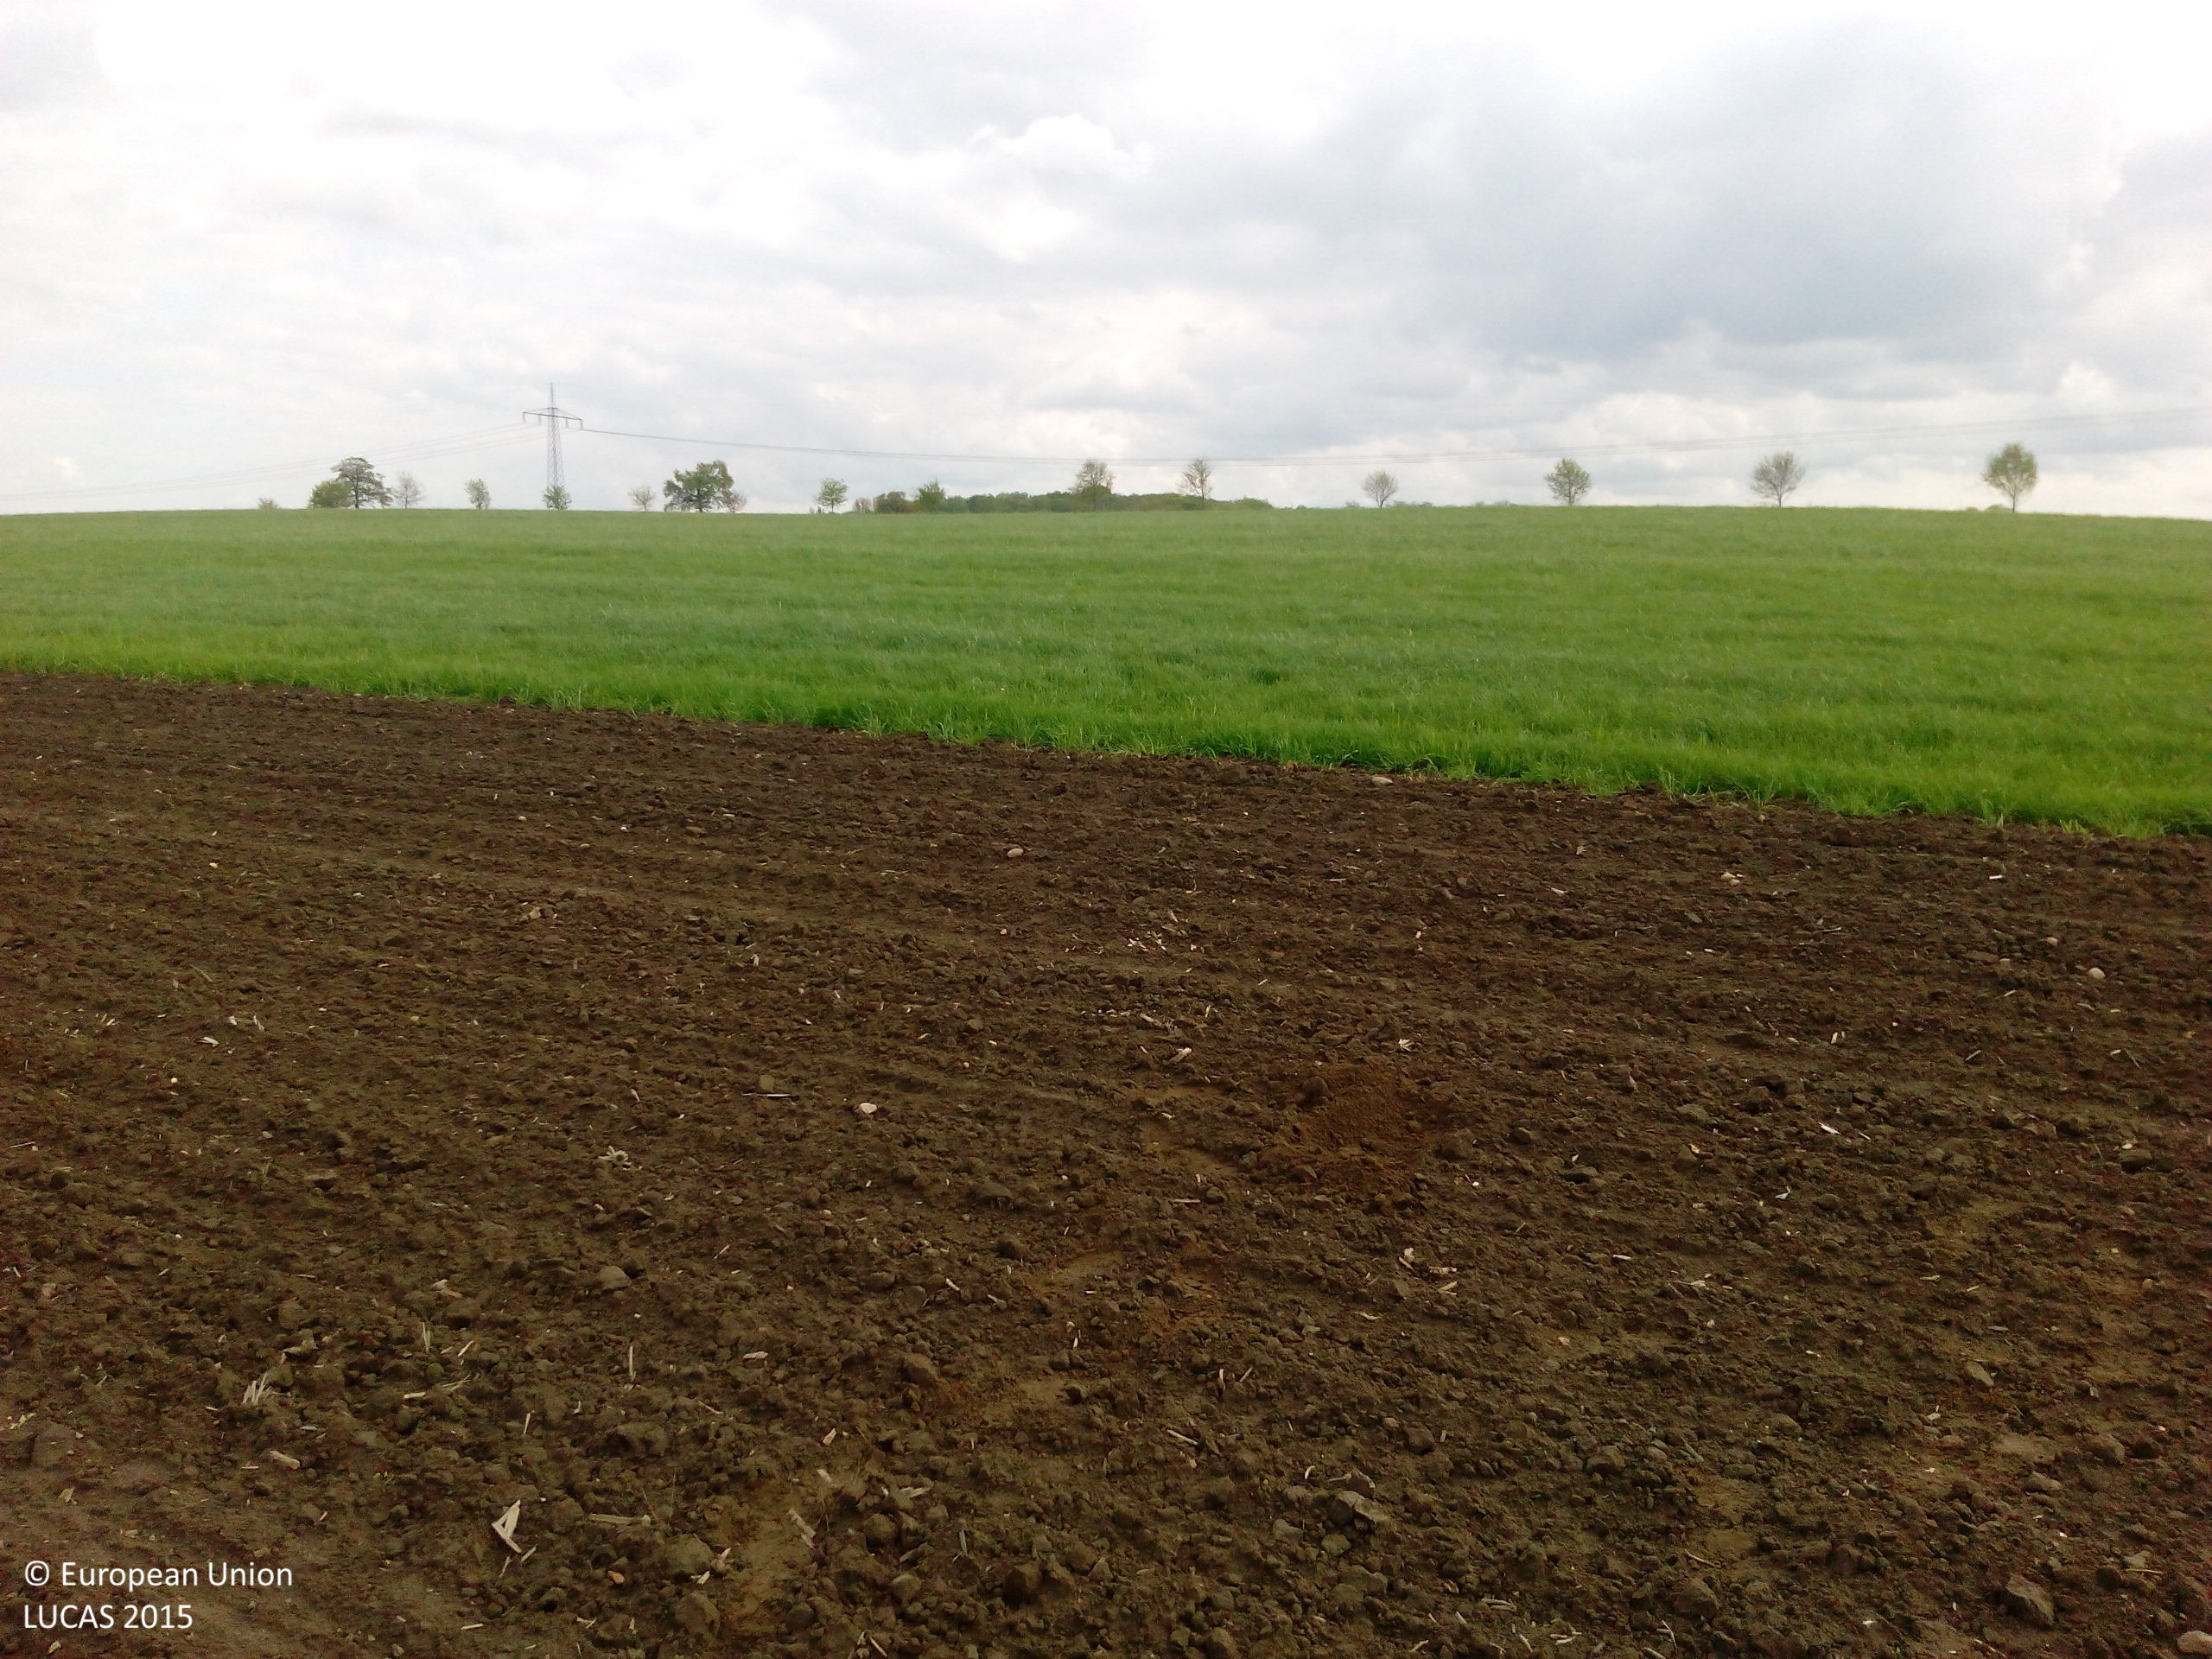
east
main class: Cropland
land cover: Maize
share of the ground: < 10 %
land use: Agriculture (excluding fallow land and kitchen gardens)
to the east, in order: Maize; Temporary grasslands; Common wheat; Grass margins; Paved roads, cycling and walking lanes; Grass margins; Lines of trees; Maize
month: May
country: DE
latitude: 51.6832
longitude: 7.3823
